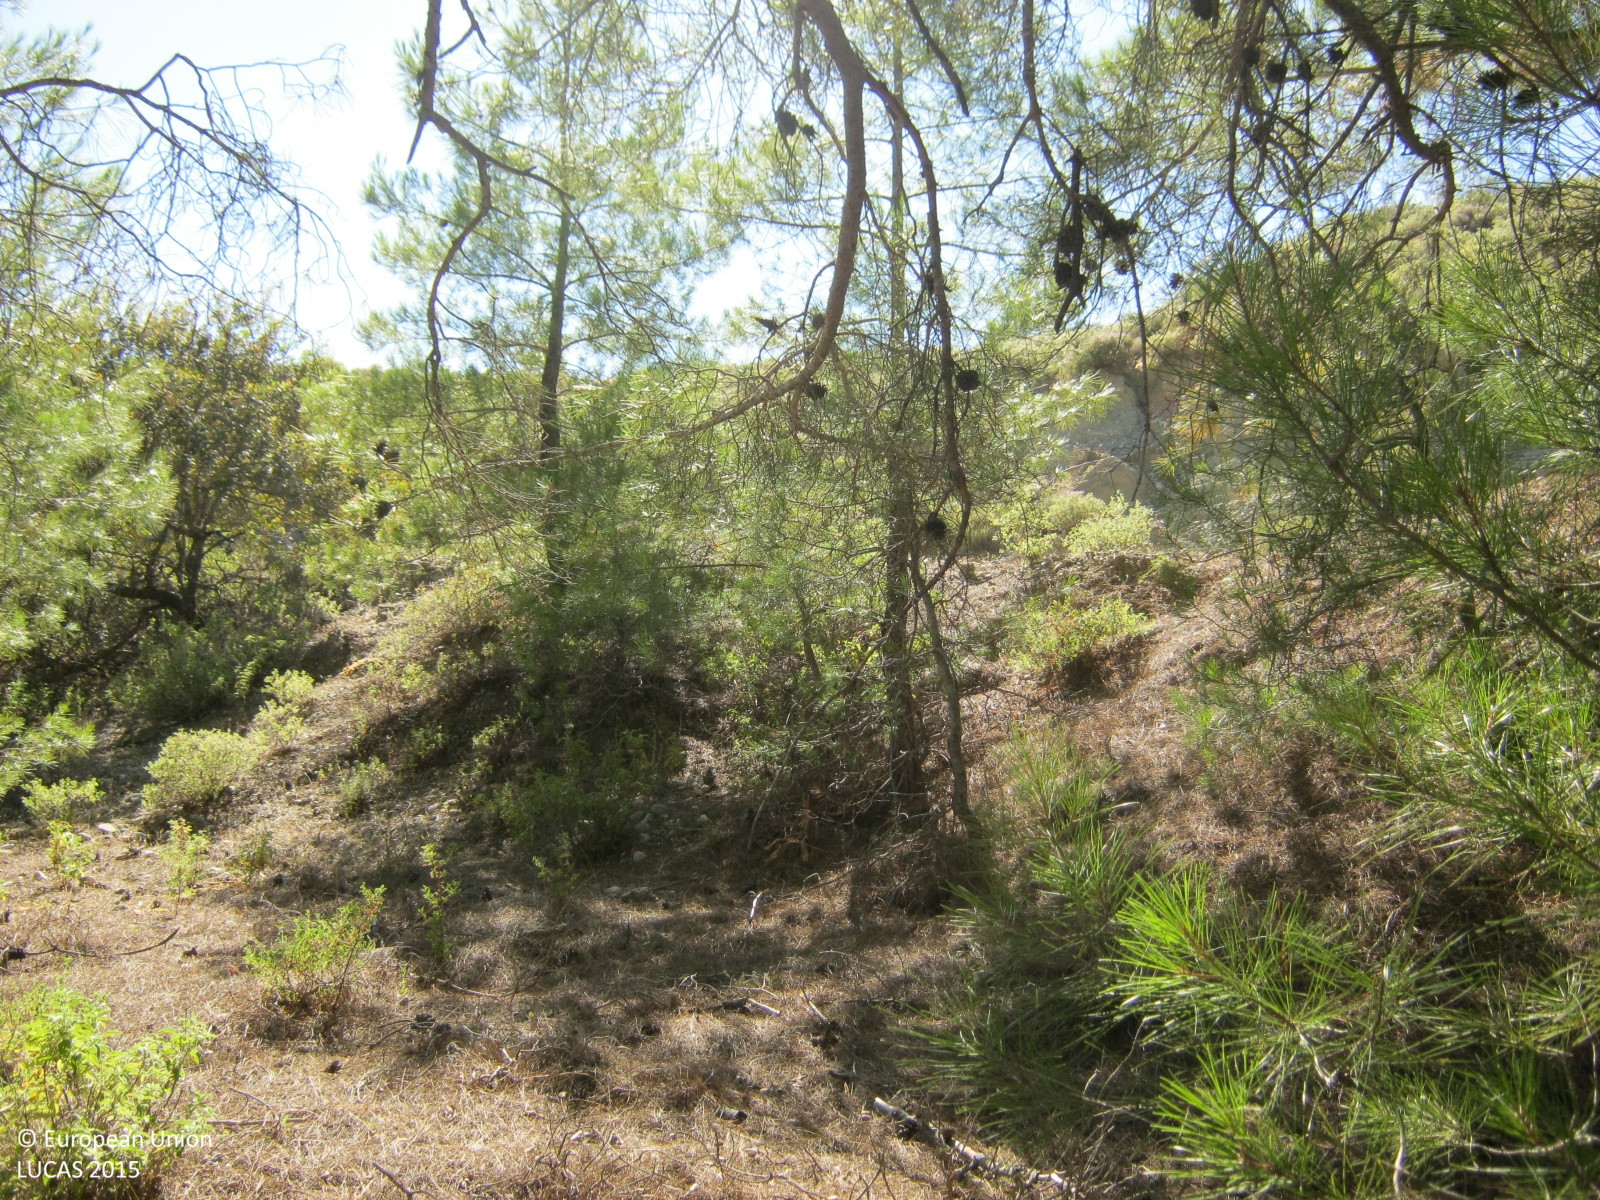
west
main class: Woodland
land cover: Pine dominated coniferous woodland
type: coniferous forest of the mediterranean region
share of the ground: > 75 %
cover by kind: coniferous forest trees 80 %, shrubs 15 %, herbaceous plants 5 %
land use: Semi-natural and natural areas not in use
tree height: > 5 m
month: June
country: GR
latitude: 36.1919
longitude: 28.0411
